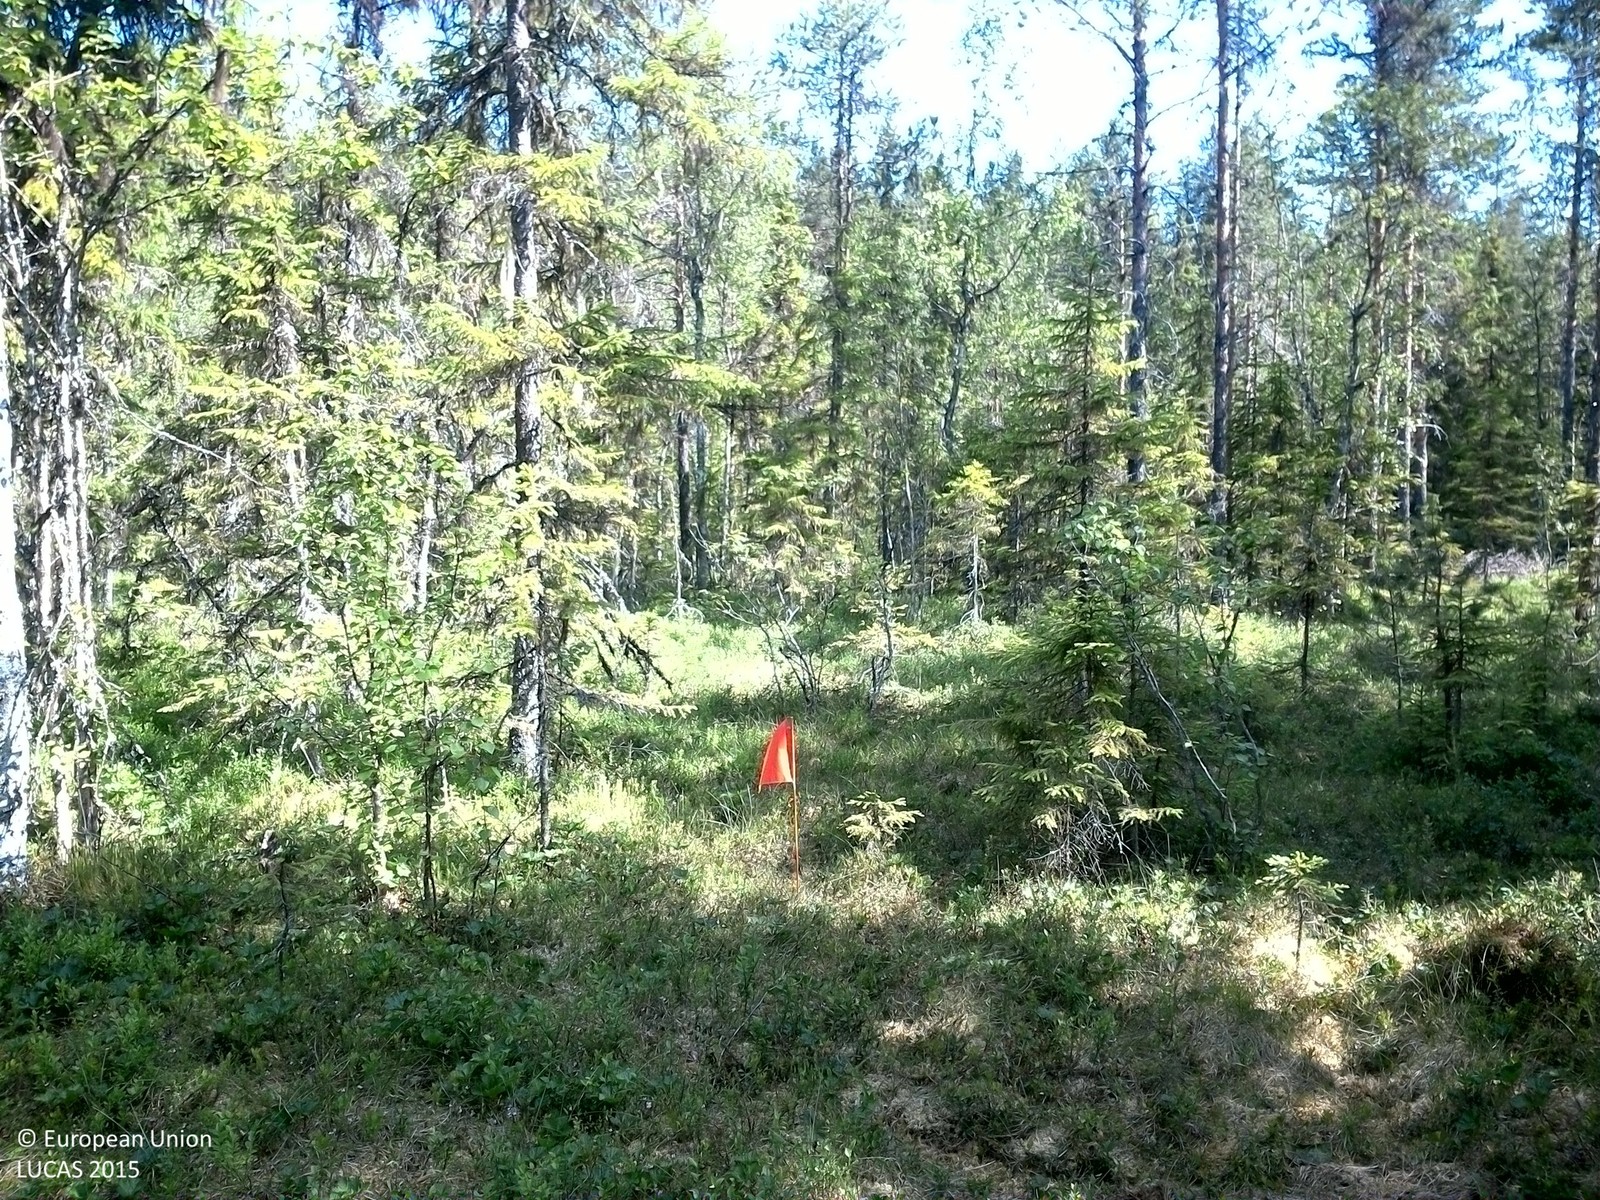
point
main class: Woodland
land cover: Spruce dominated coniferous woodland
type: boreal forest
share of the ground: 25 - 50 %
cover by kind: coniferous forest trees 35 %, lichens and mosses 30 %, shrubs 20 %, broadleaved forest trees 10 %, herbaceous plants 5 %
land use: Forestry
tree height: > 5 m
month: July
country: SE
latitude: 63.4989
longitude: 17.7882
